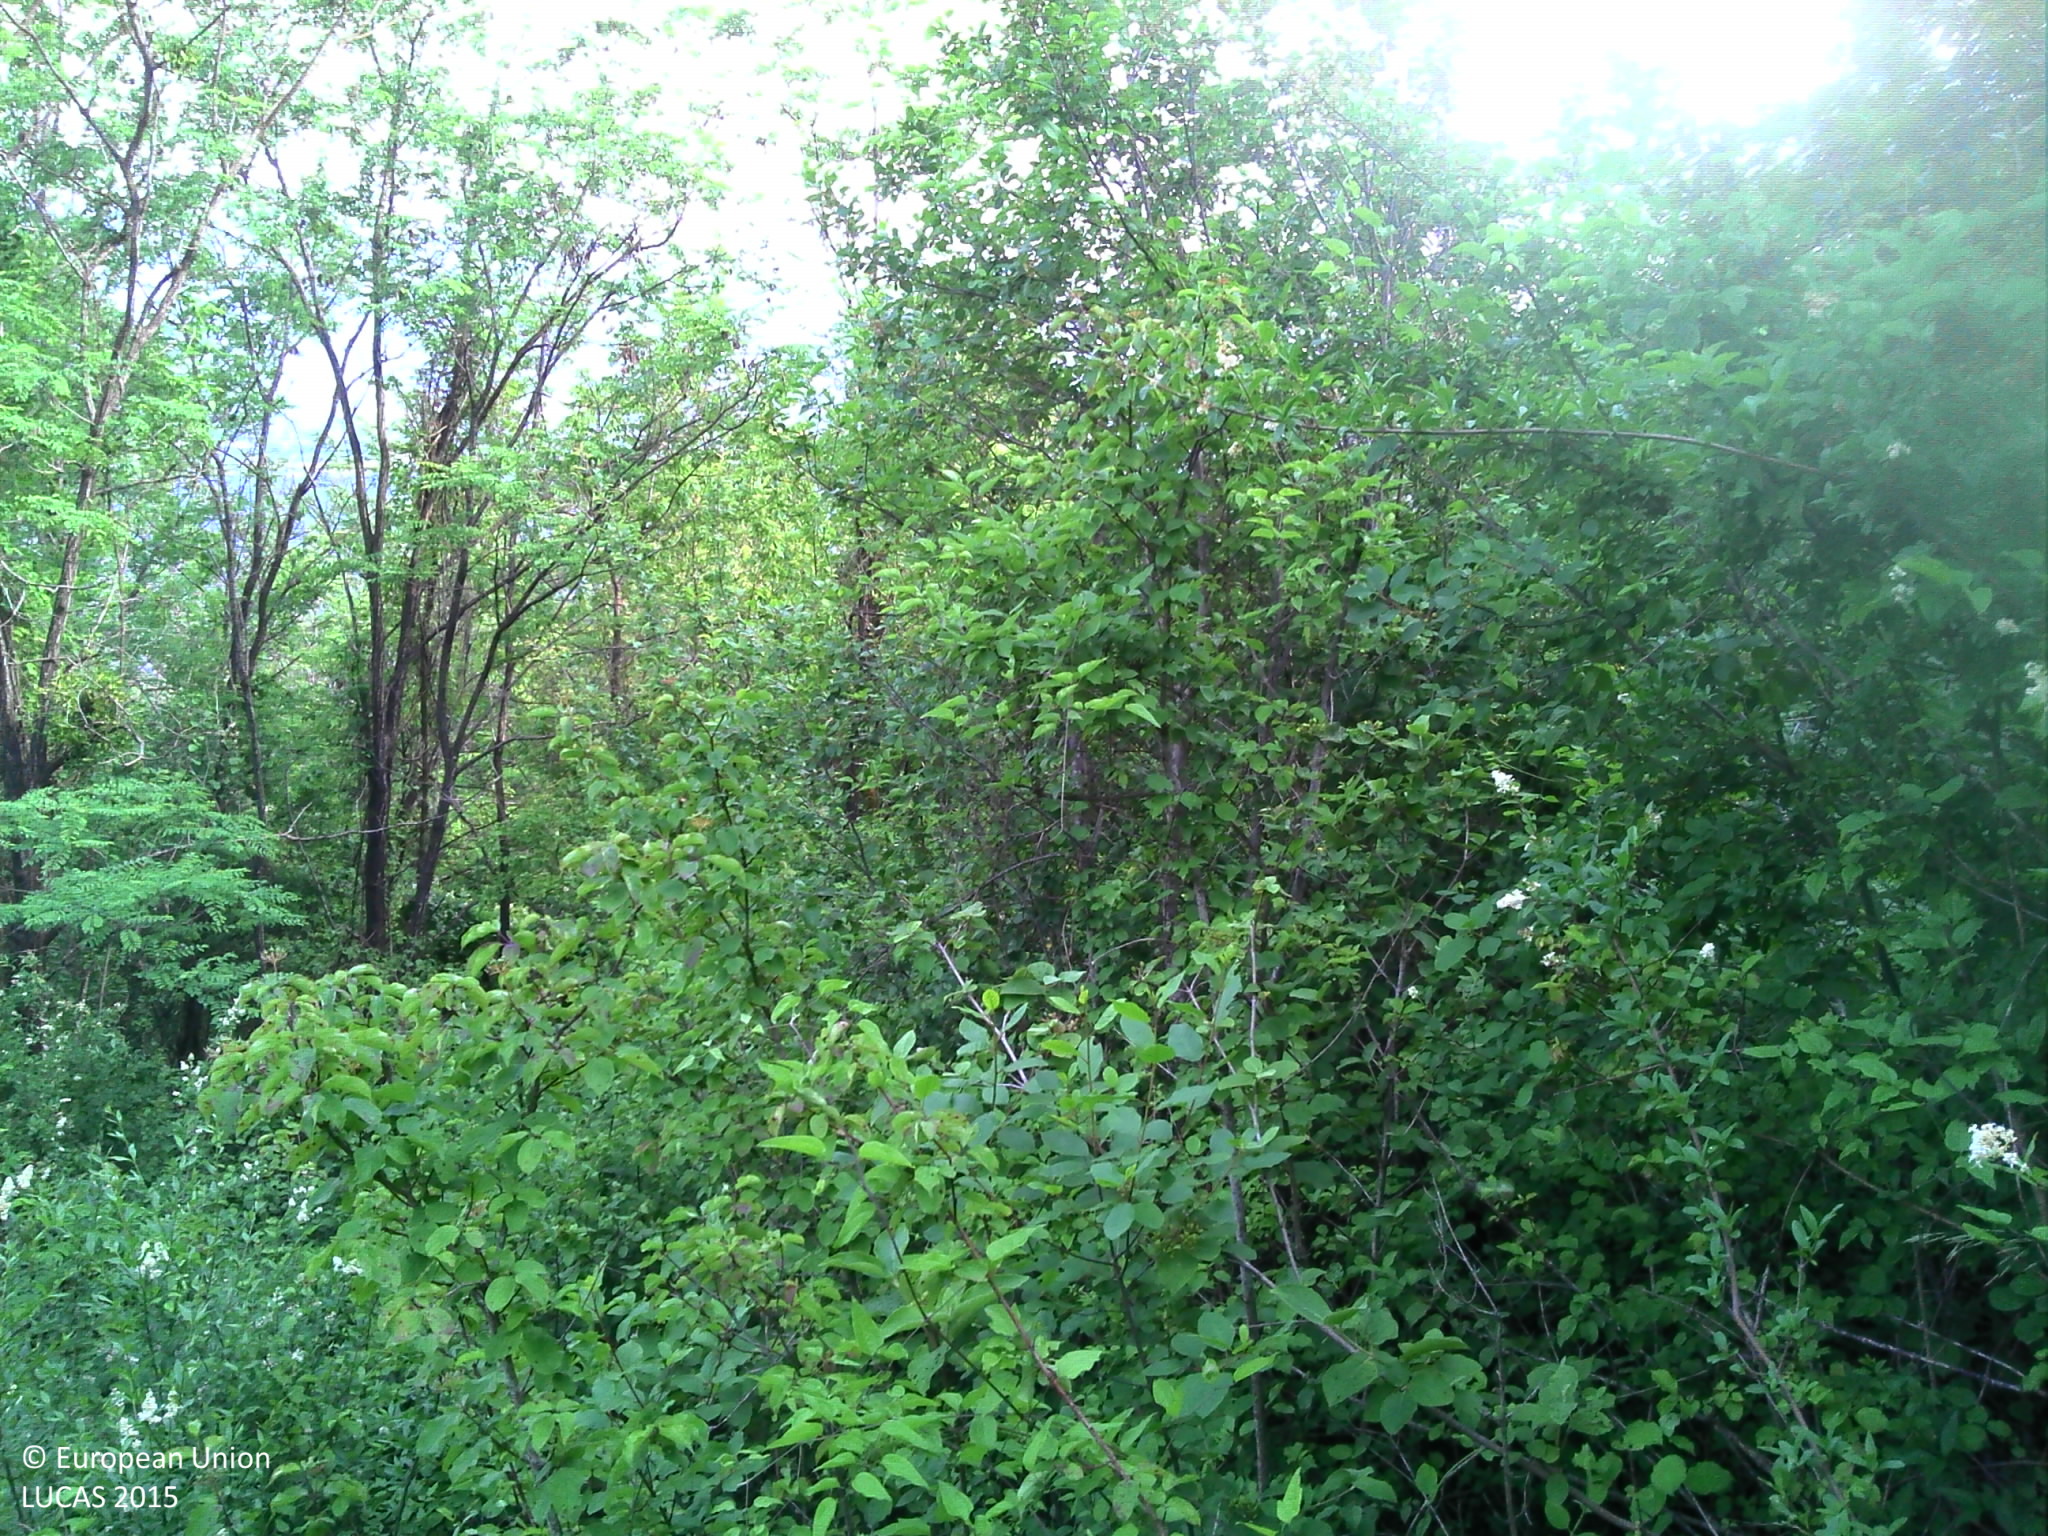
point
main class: Shrubland
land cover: Shrubland with sparse tree cover
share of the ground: > 75 %
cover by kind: shrubs 80 %, herbaceous plants 15 %, broadleaved forest trees 5 %
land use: Forestry
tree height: > 5 m
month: June
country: FR
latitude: 45.5784
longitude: 6.1471
